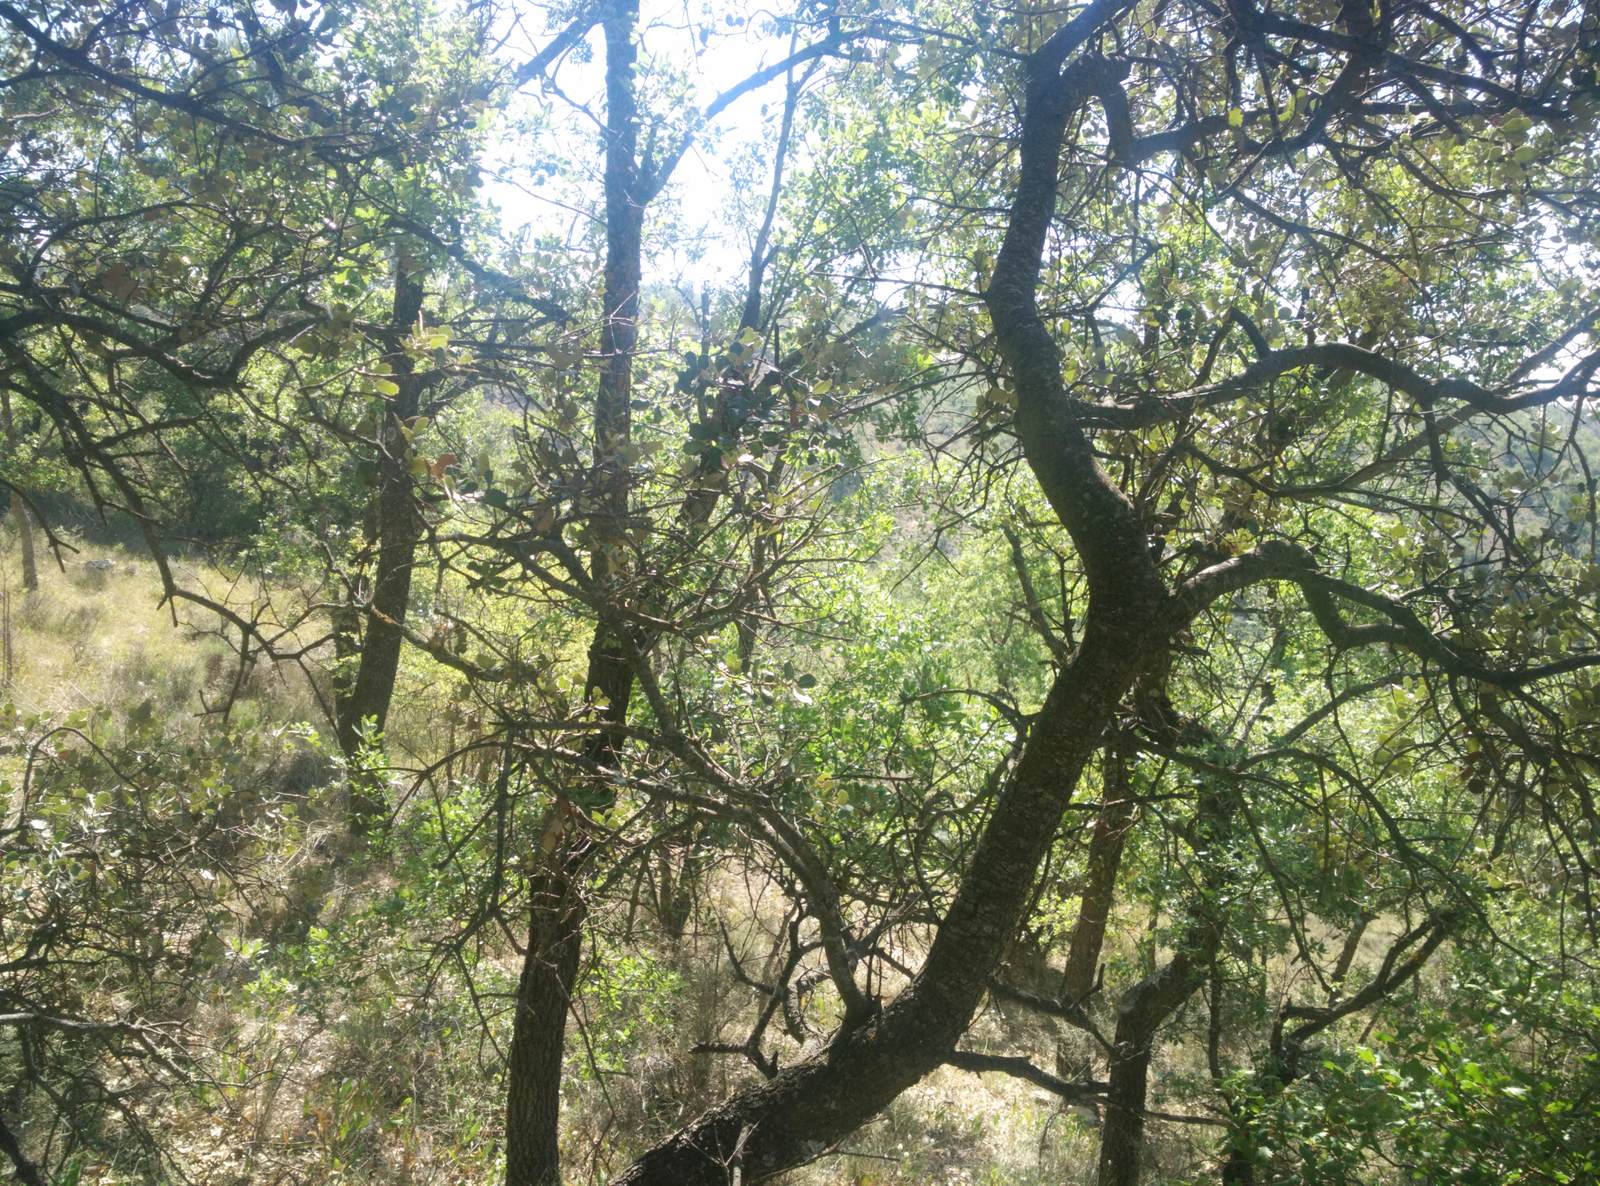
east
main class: Woodland
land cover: Broadleaved woodland
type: thermophilous deciduous forest
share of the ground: 25 - 50 %
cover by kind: unconsolidated bare surface 40 %, broadleaved forest trees 30 %, herbaceous plants 20 %, shrubs 10 %
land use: Semi-natural and natural areas not in use
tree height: > 5 m
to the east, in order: Broadleaved woodland; Rivers and streams; Broadleaved woodland
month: July
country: ES
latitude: 40.5305
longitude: -2.5982
